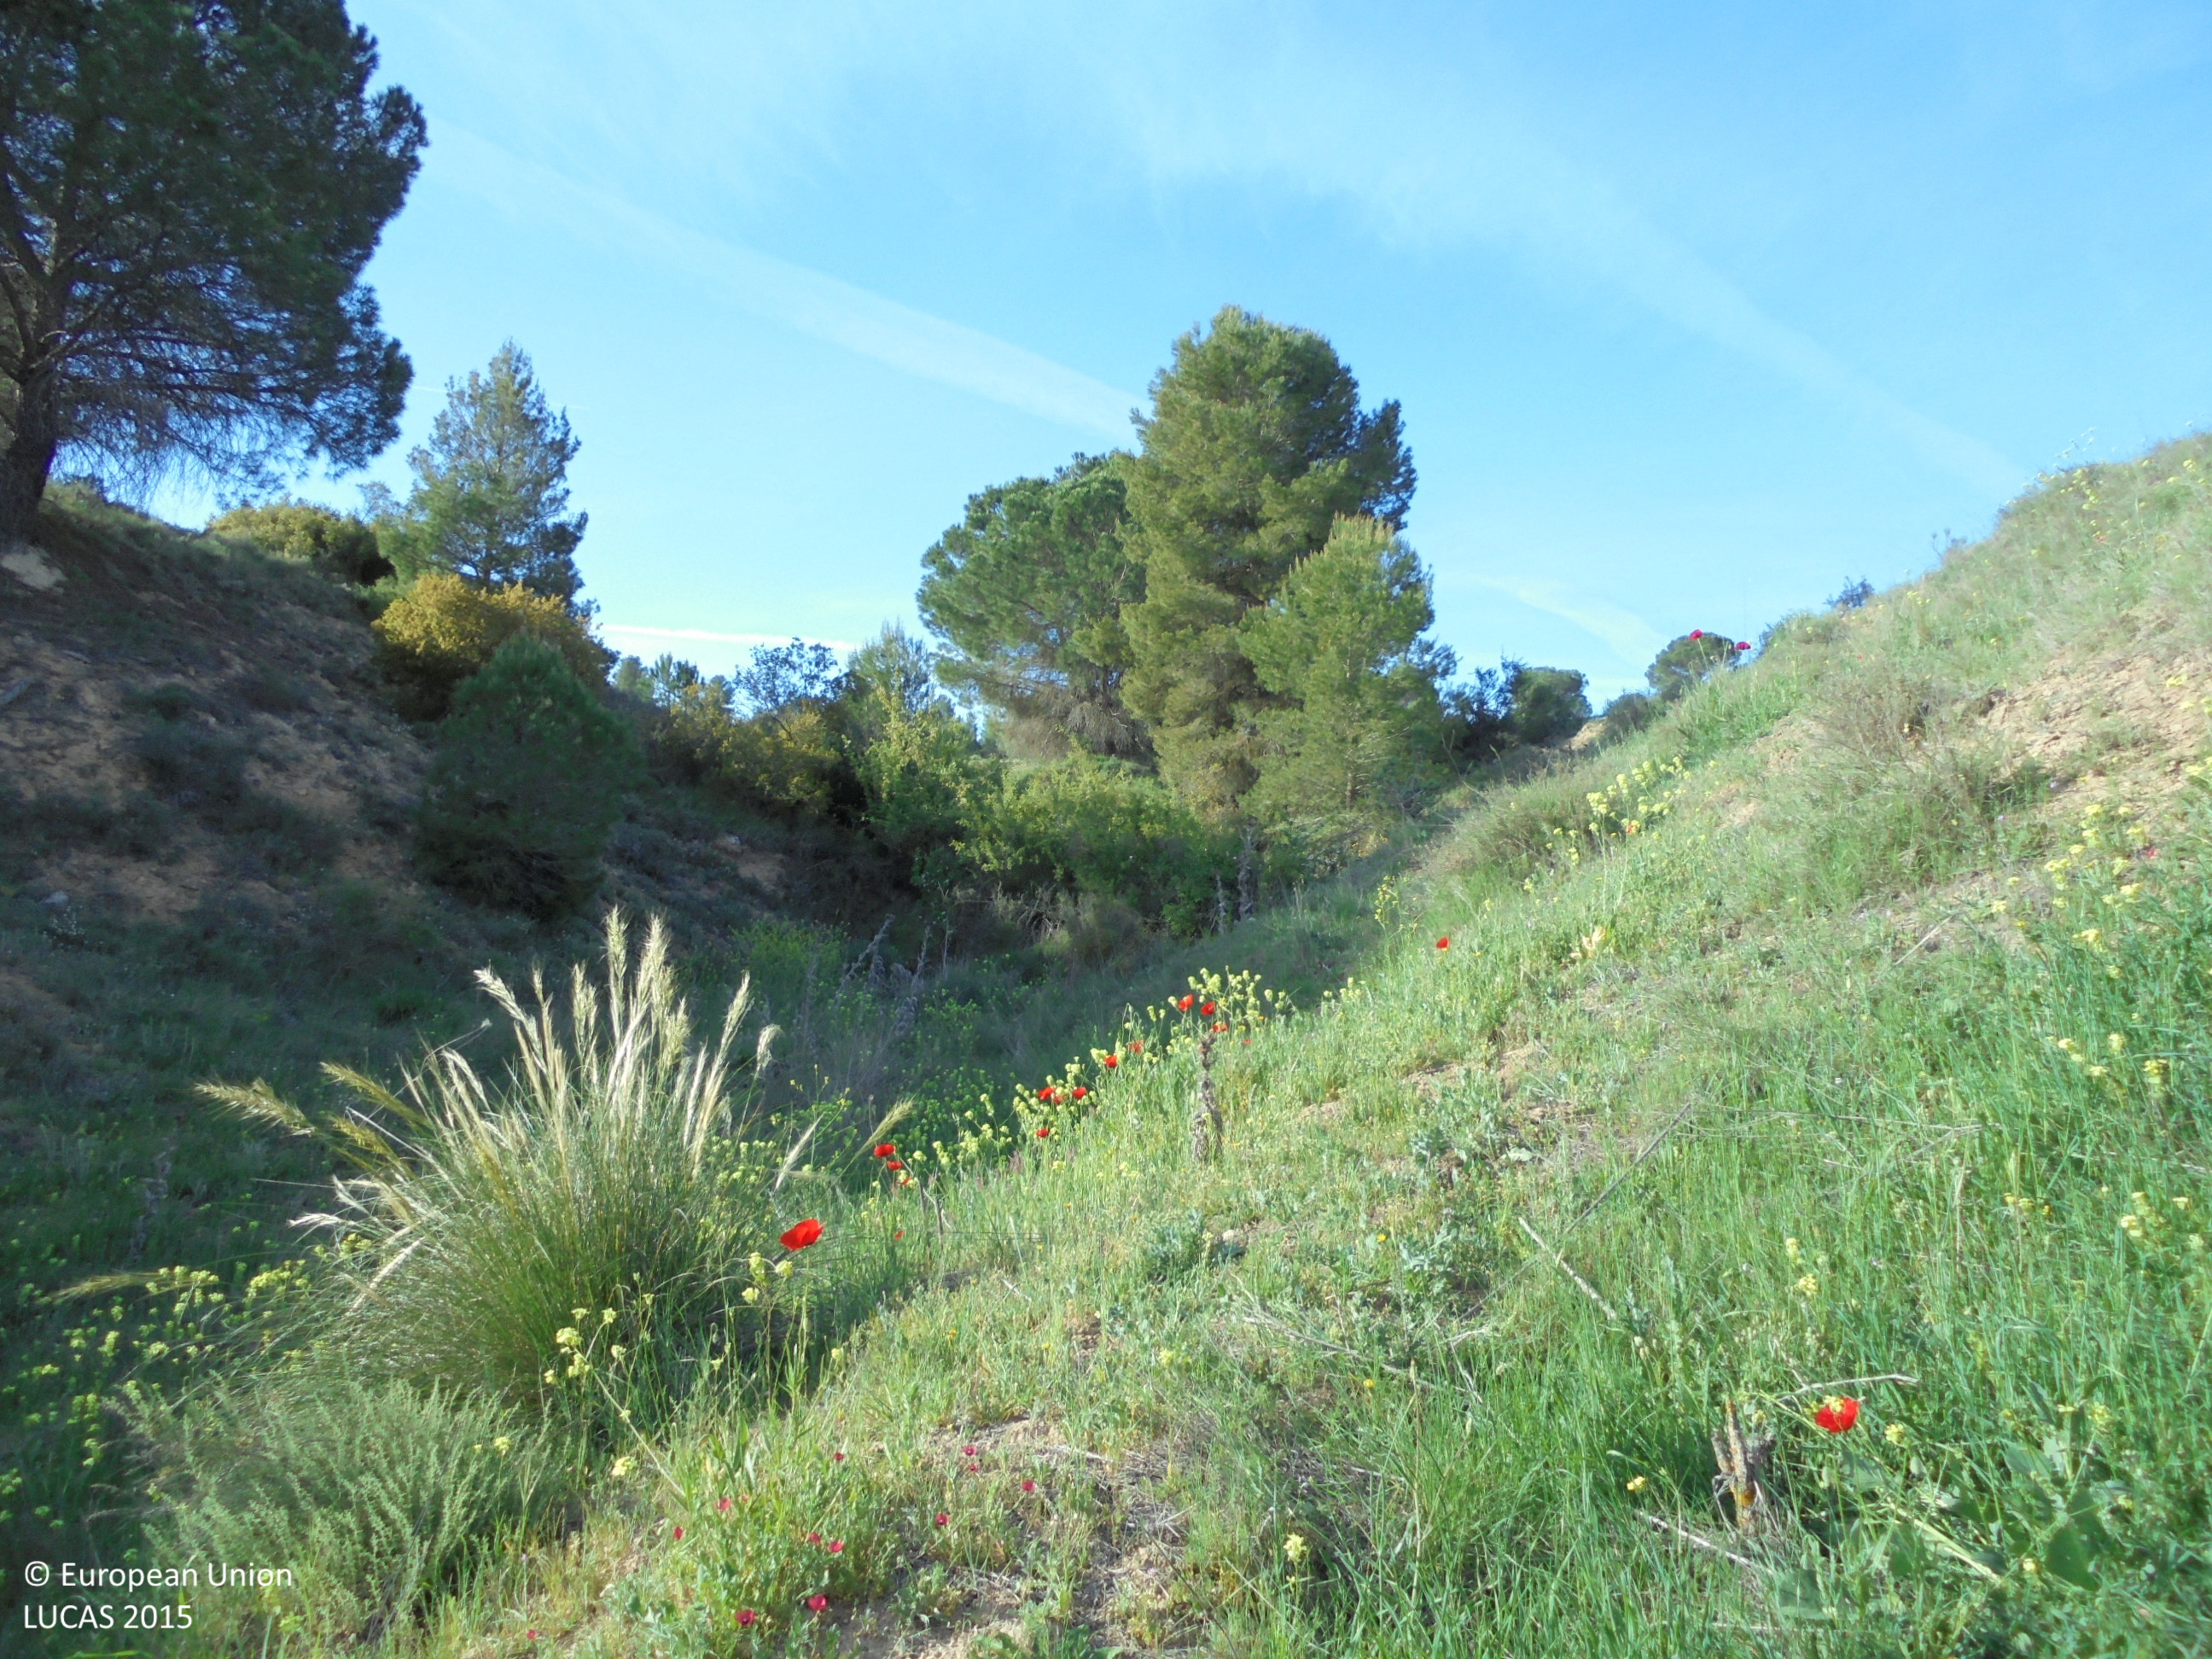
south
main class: Shrubland
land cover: Shrubland with sparse tree cover
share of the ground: 10 - 25 %
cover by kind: herbaceous plants 75 %, shrubs 15 %, coniferous forest trees 5 %, unconsolidated bare surface 5 %
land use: Semi-natural and natural areas not in use
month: May
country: ES
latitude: 39.1598
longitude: -1.7247
